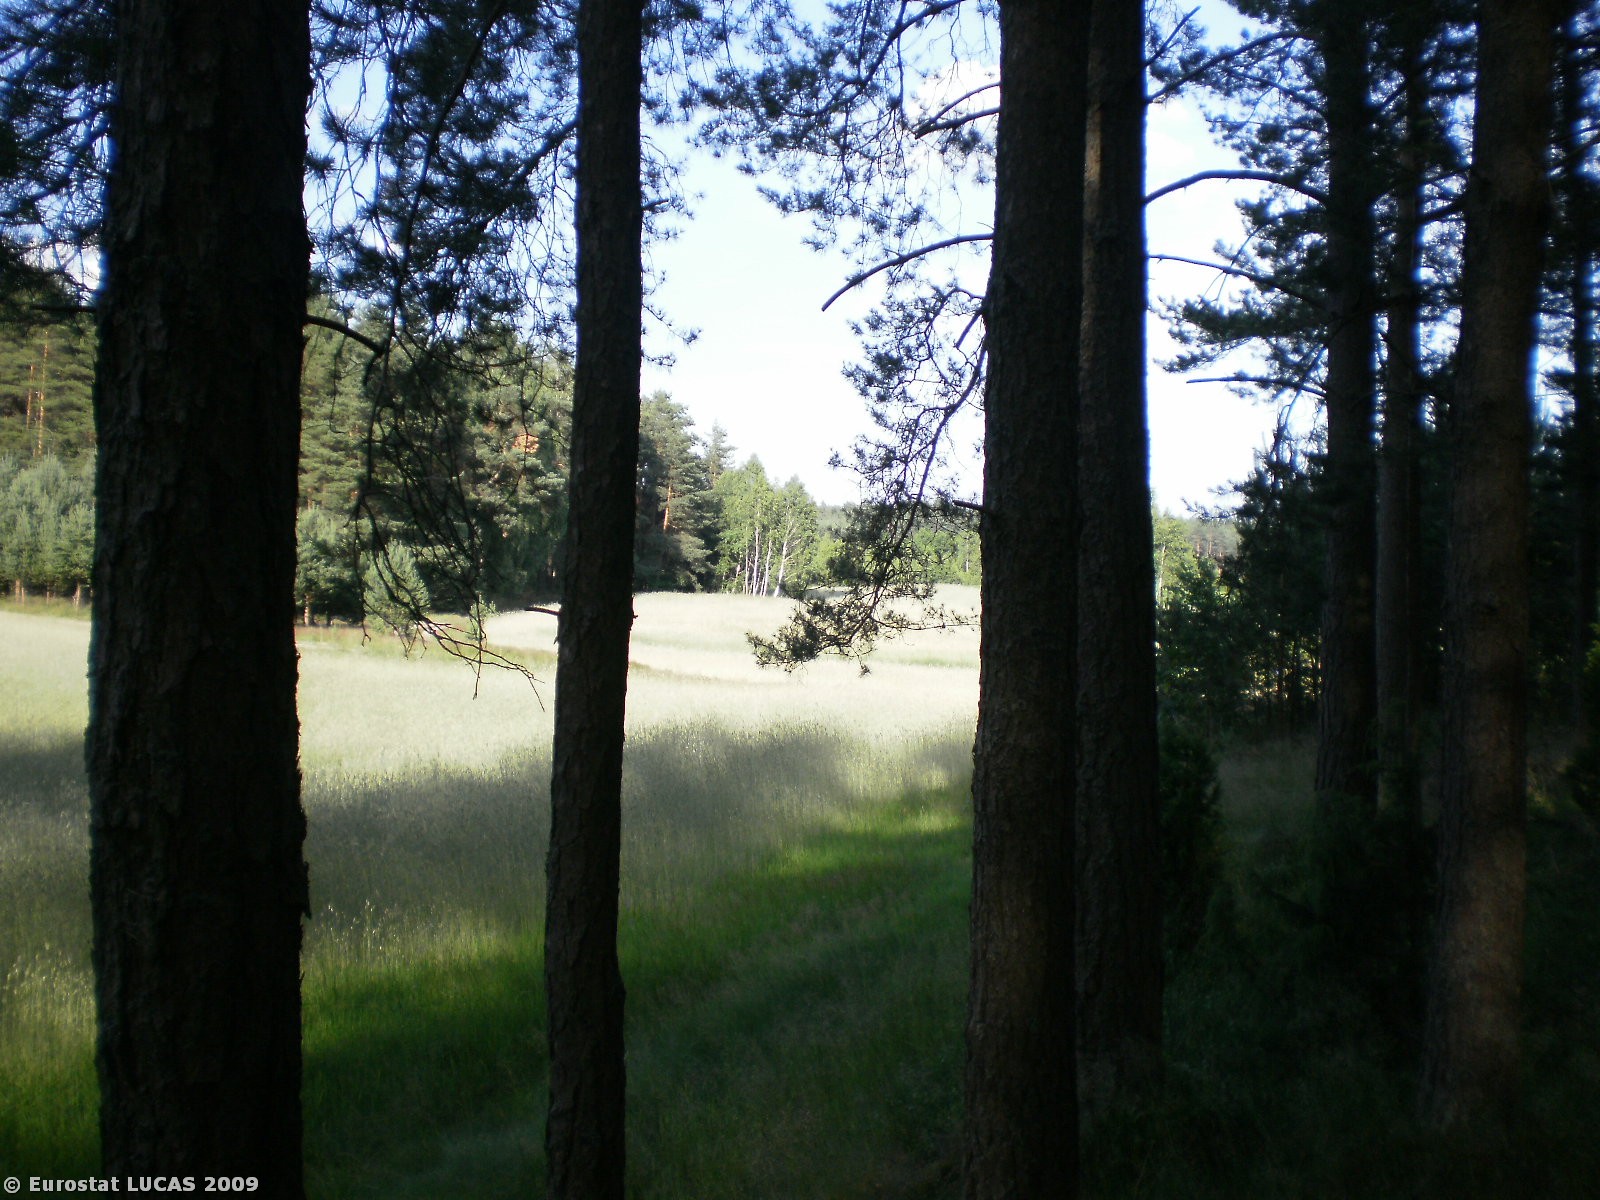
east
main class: Cropland
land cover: Arable land (only in case pi)
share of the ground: > 75 %
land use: Agriculture (excluding fallow land and kitchen gardens)
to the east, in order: Triticale; Coniferous woodland; Grass margins; Abandoned hedges; Grass margins; Tracks; Grass margins; Abandoned hedges; Grassland with sparse tree/shrub cover; Rye; Potatoes; Sugar beet
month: July
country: PL
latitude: 54.1076
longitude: 17.7980
